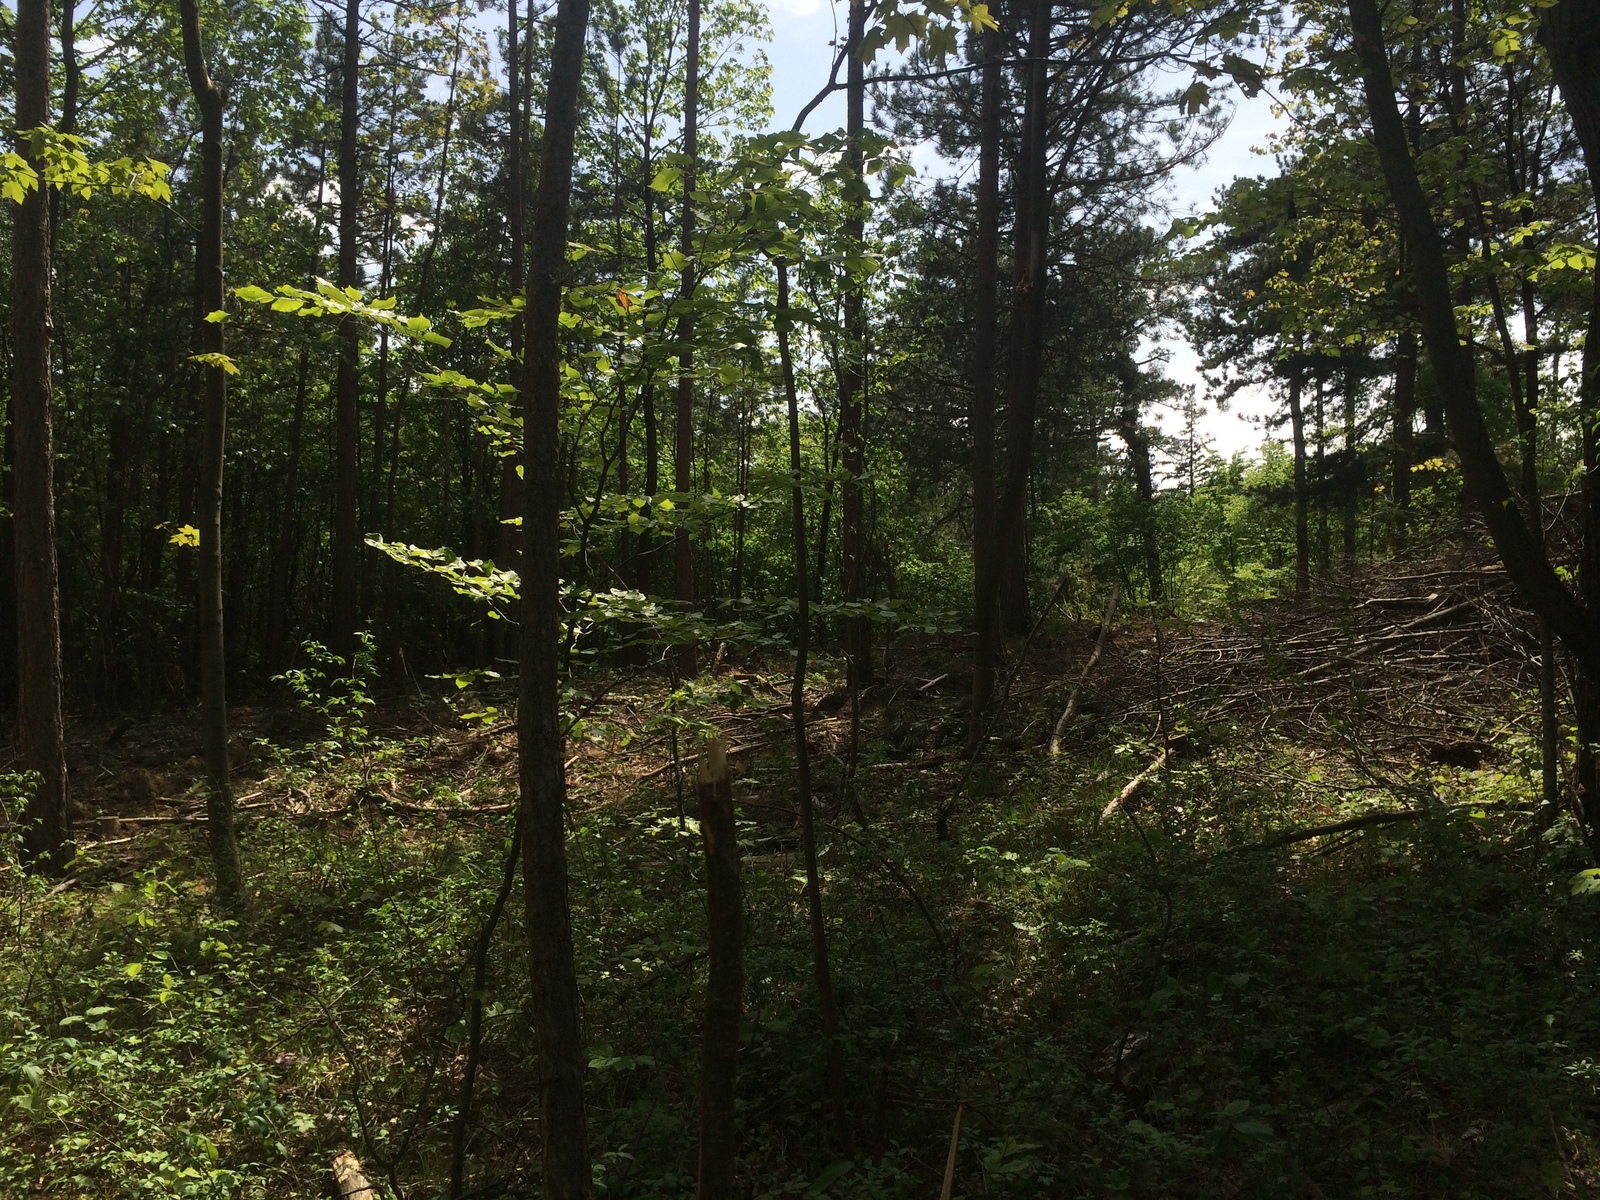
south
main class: Woodland
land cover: Pine dominated mixed woodland
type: alpine coniferous forest
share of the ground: > 75 %
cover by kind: coniferous forest trees 40 %, broadleaved forest trees 40 %, shrubs 10 %, herbaceous plants 10 %
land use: Forestry
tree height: > 5 m
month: May
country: AT
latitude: 47.9242
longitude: 16.1733
